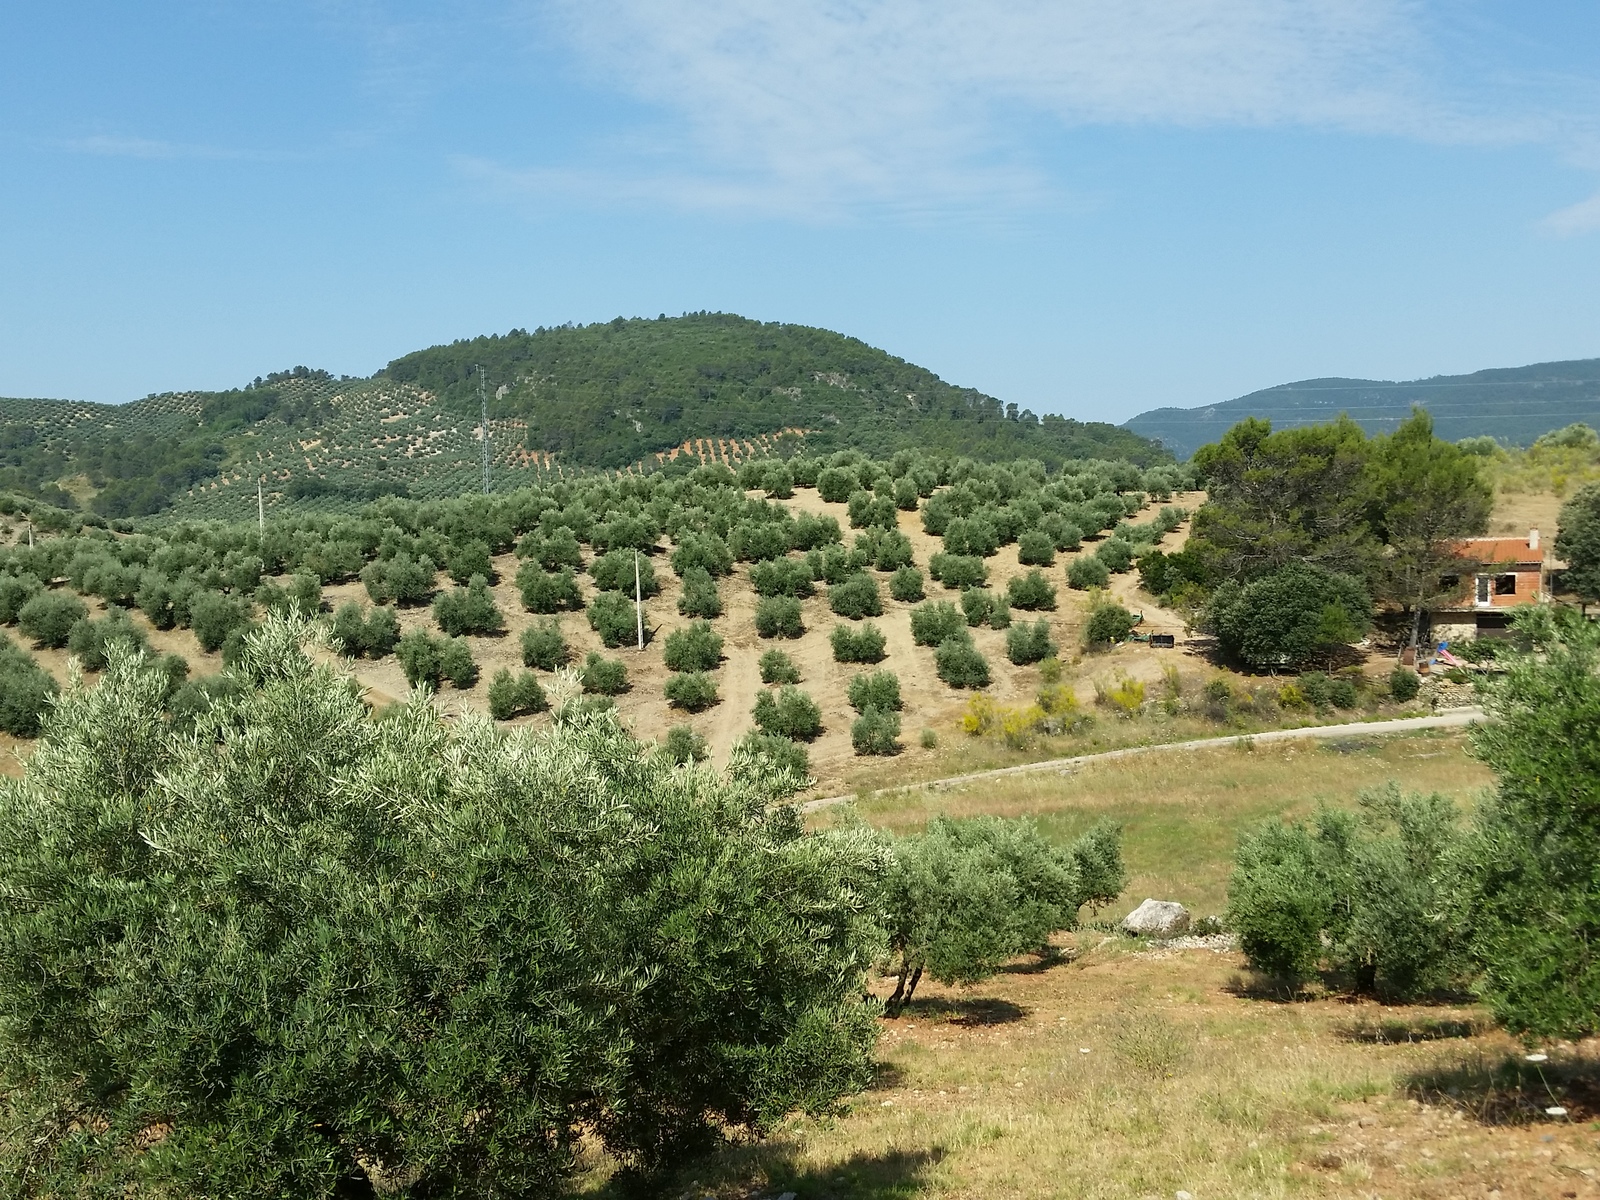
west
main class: Cropland
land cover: Olive groves
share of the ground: 50 - 75 %
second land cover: Grassland without tree/shrub cover
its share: 25 - 50 %
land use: Agriculture (excluding fallow land and kitchen gardens)
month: June
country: ES
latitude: 38.4163
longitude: -2.5394
